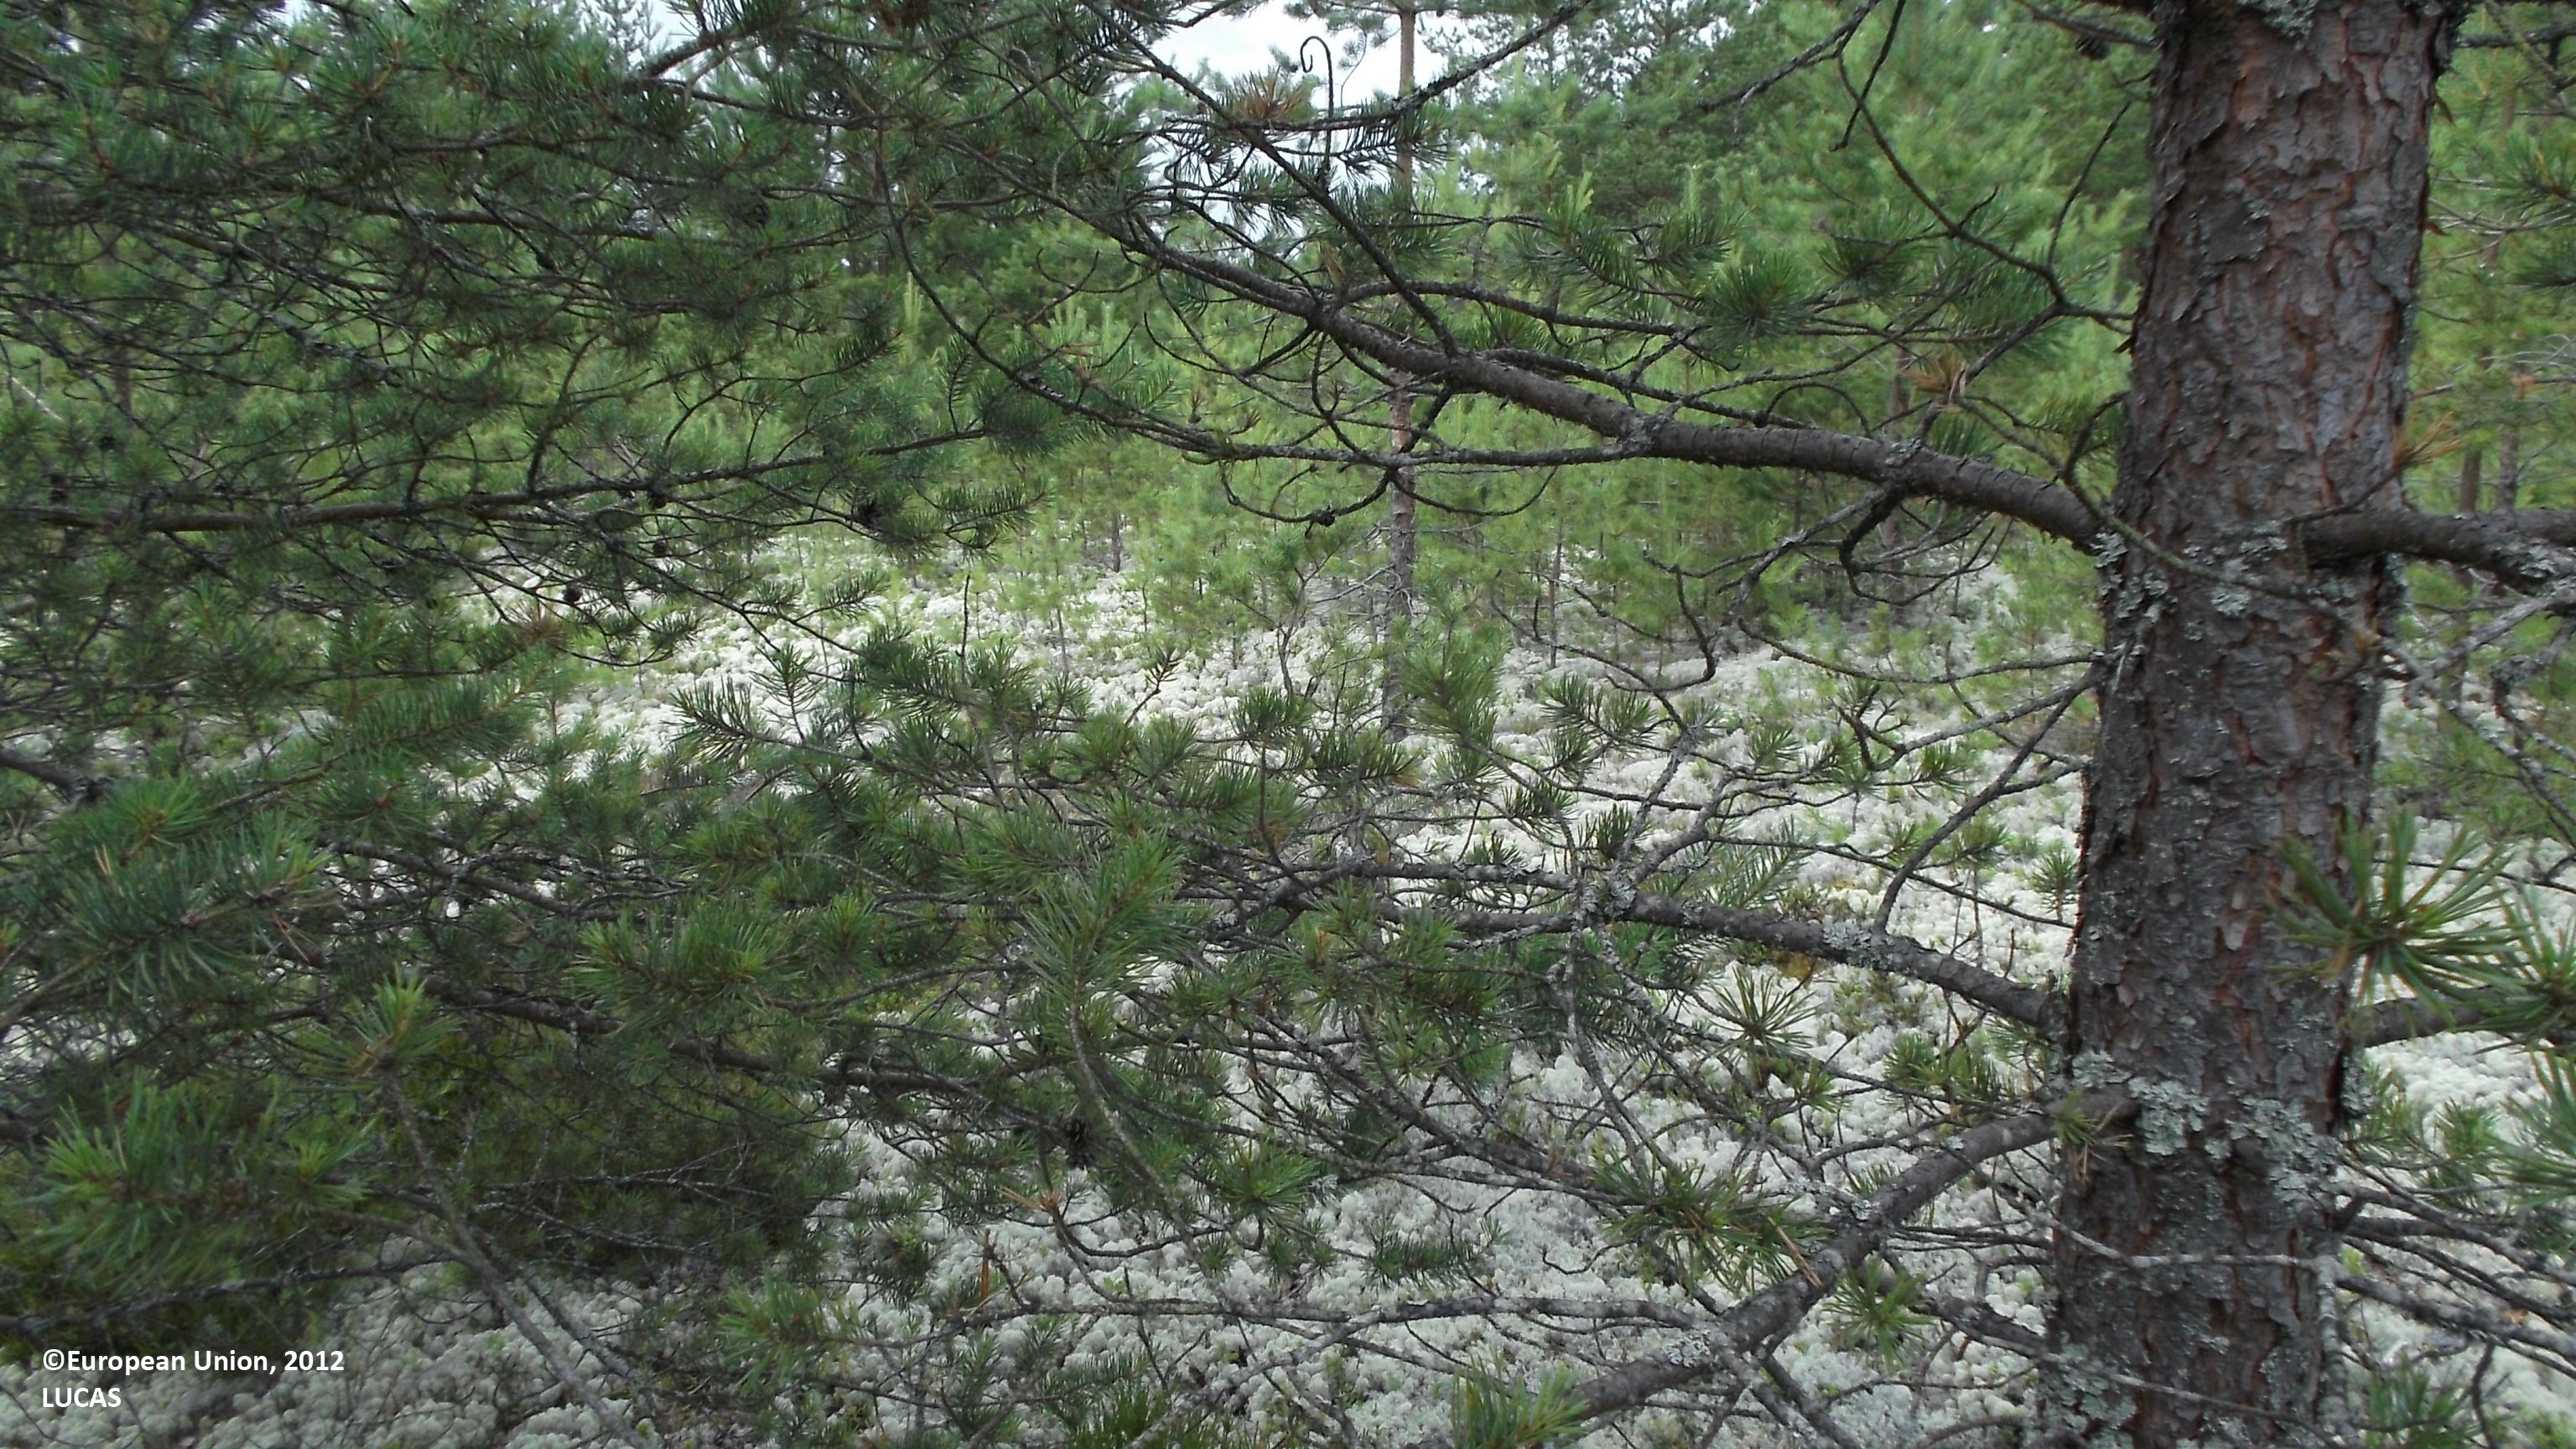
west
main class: Woodland
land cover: Pine dominated coniferous woodland
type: boreal forest
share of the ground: 25 - 50 %
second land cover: Lichens and moss
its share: 50 - 75 %
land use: Forestry
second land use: Semi-natural and natural areas not in use
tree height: > 5 m
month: July
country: FI
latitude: 63.9815
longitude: 23.5224
